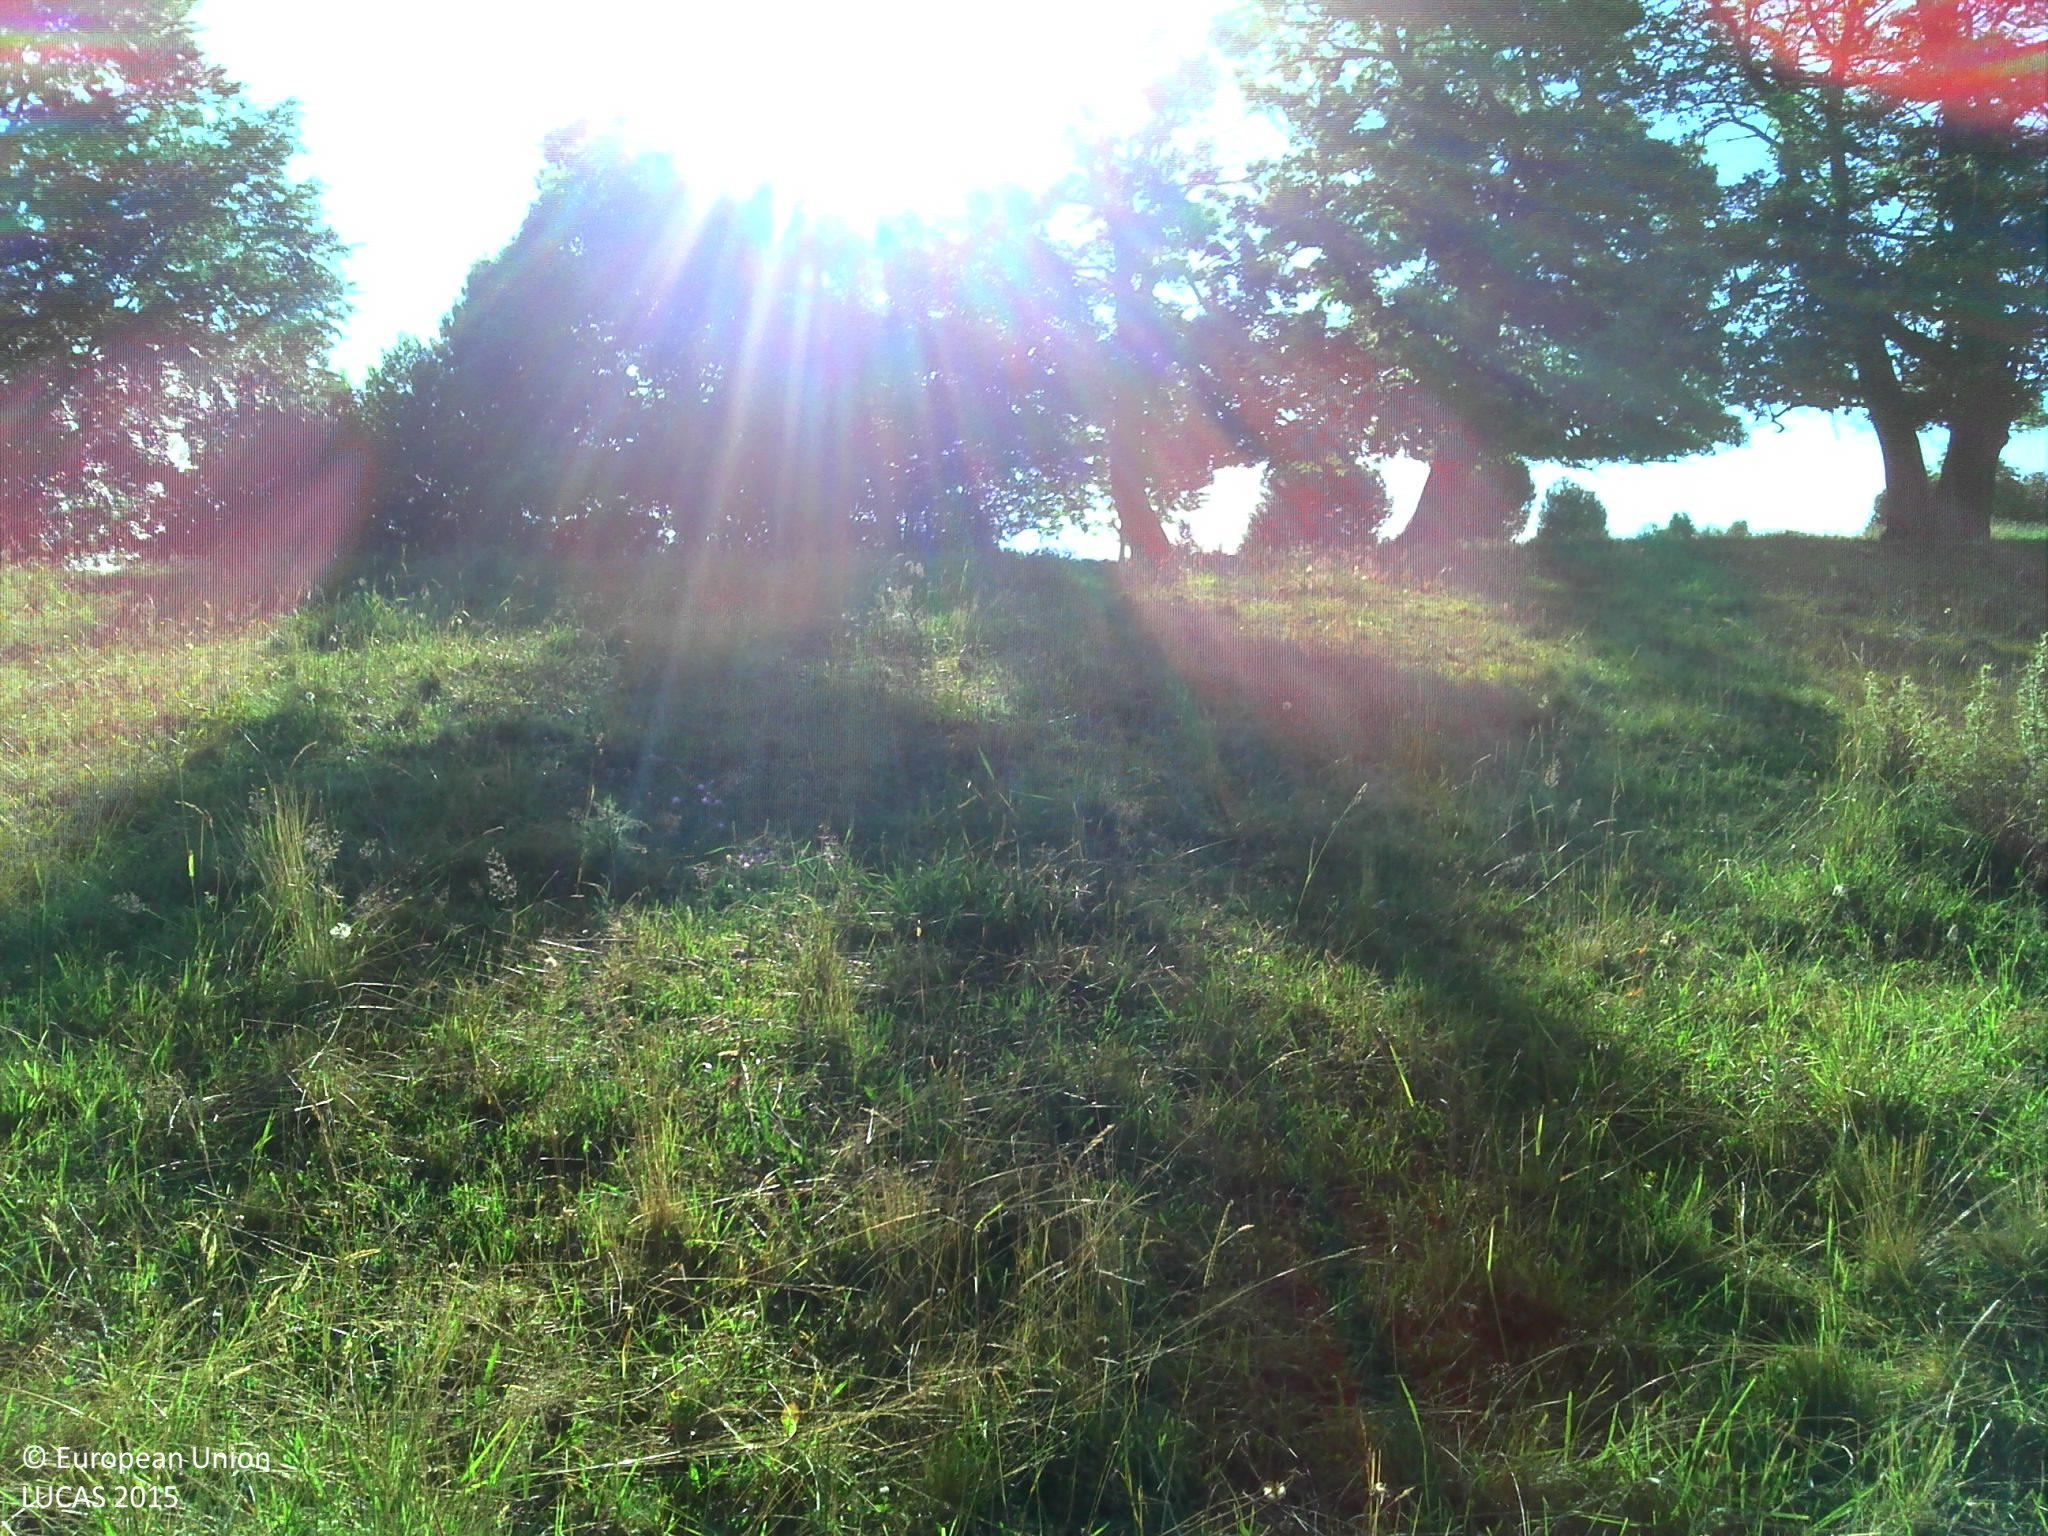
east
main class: Grassland
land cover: Grassland without tree/shrub cover
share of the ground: > 75 %
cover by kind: herbaceous plants 100 %
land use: Agriculture (excluding fallow land and kitchen gardens)
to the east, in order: Grassland without tree/shrub cover; Lines of trees; Grassland without tree/shrub cover; Fences; Abandoned hedges; Fences; Grassland without tree/shrub cover; Tracks; Grassland without tree/shrub cover; Fences; Common wheat; Electric lines; Common wheat
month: June
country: FR
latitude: 44.8678
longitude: 2.3938
